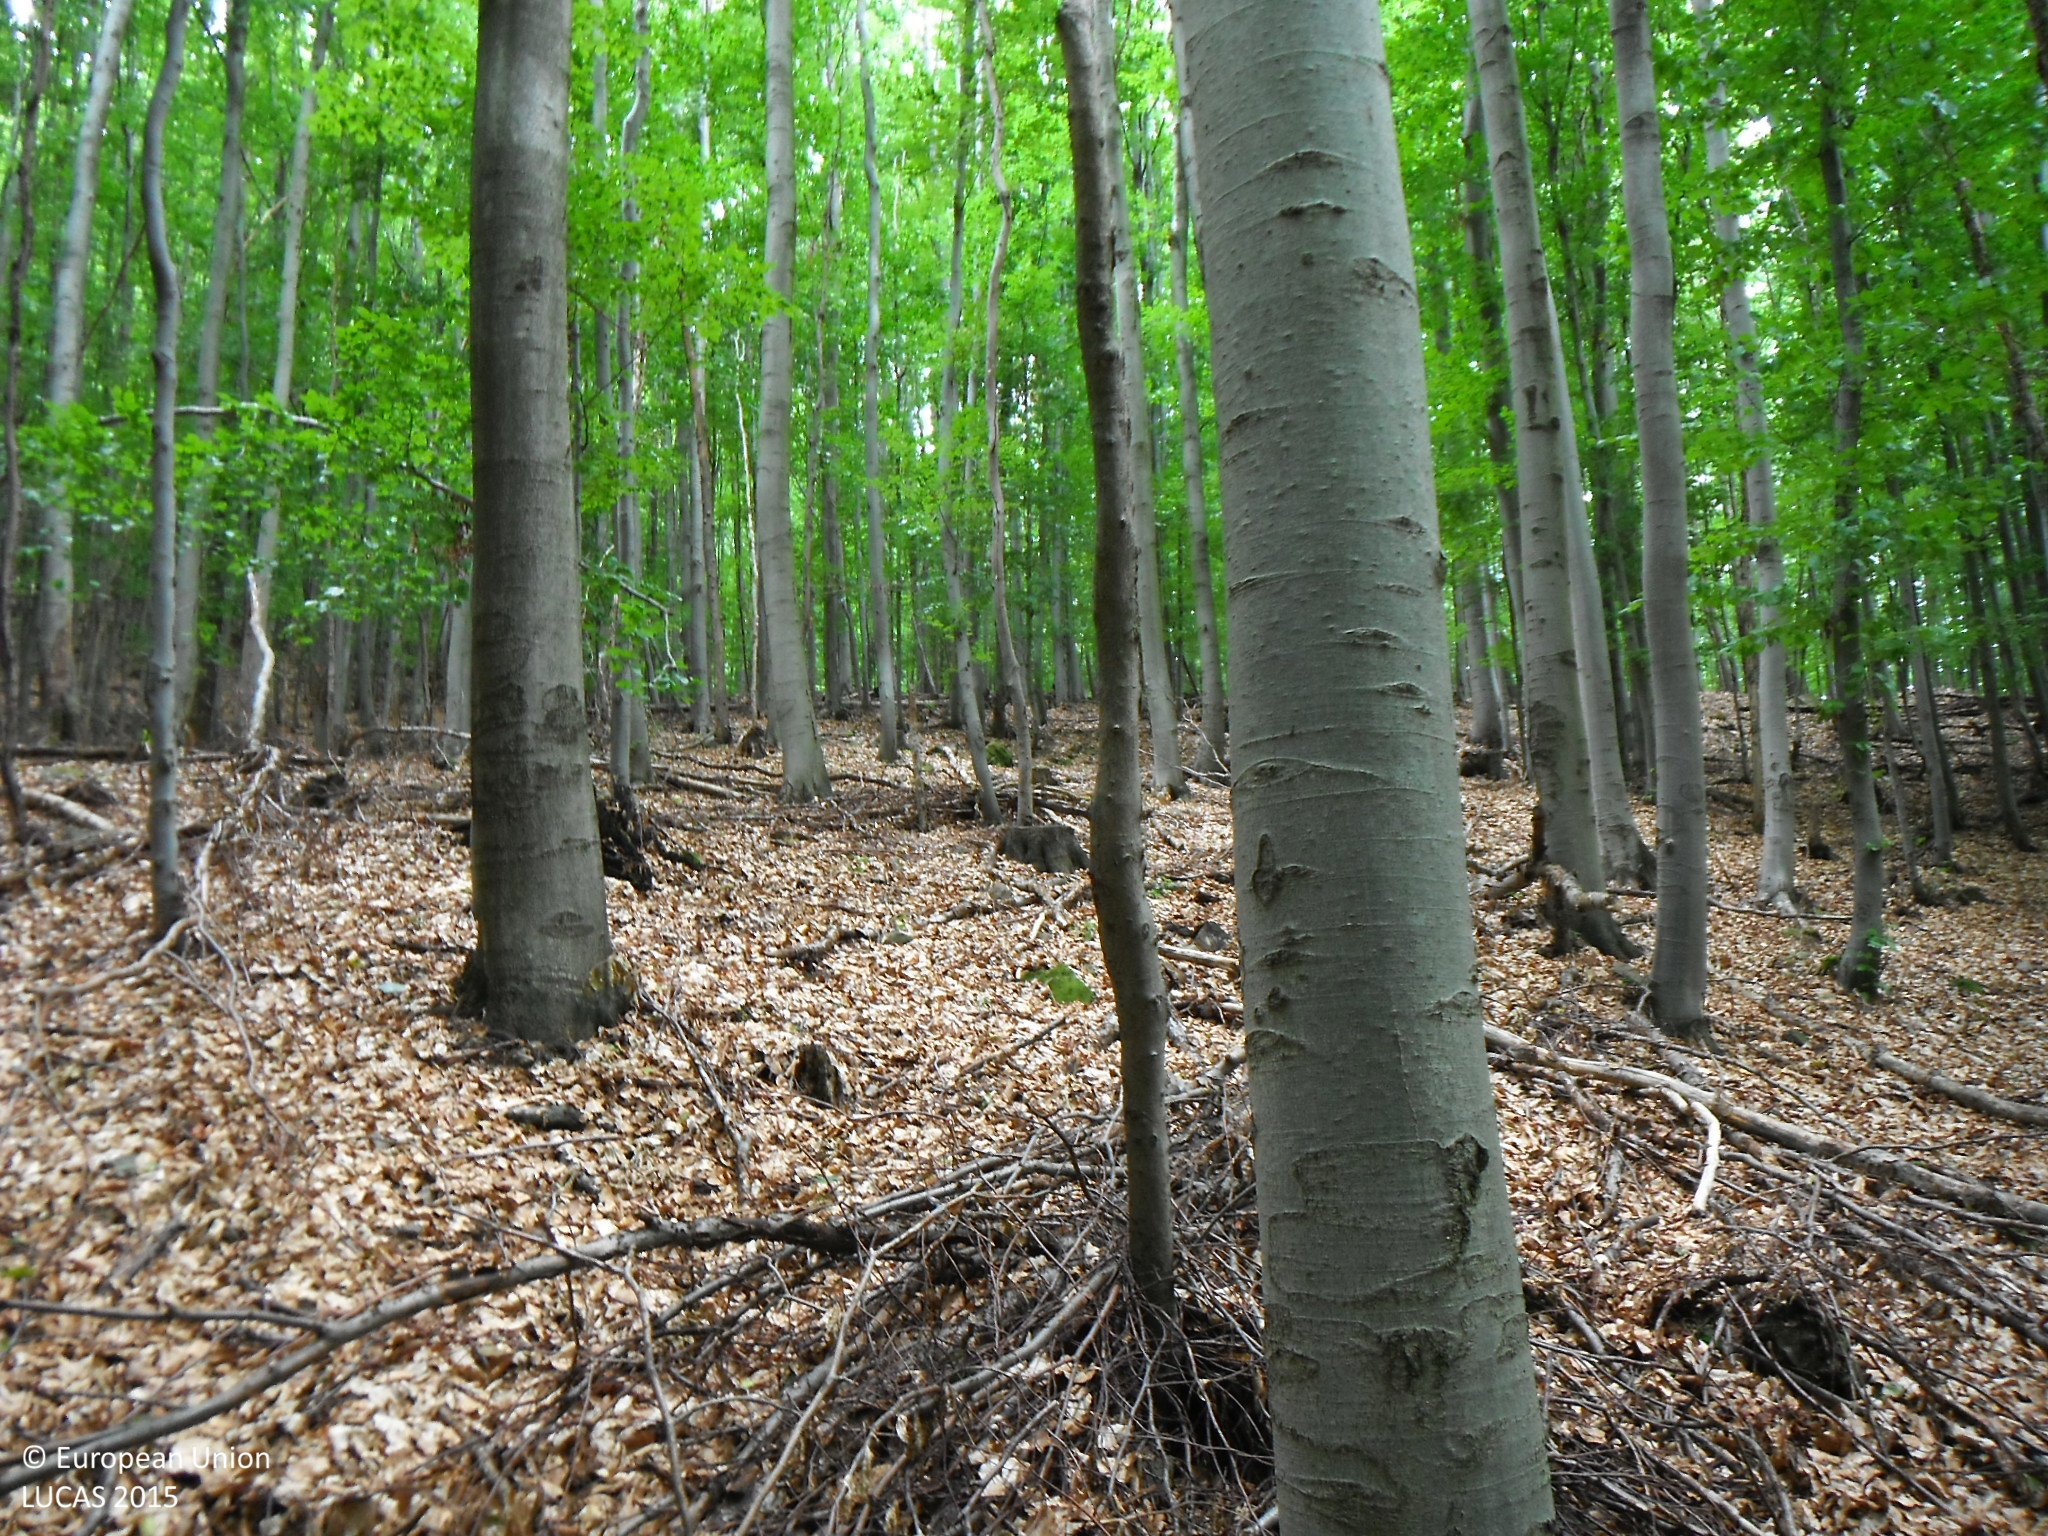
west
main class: Woodland
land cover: Broadleaved woodland
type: beech forest
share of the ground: > 75 %
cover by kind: broadleaved forest trees 100 %
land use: Forestry
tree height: > 5 m
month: July
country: SK
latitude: 48.5880
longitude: 21.4482
